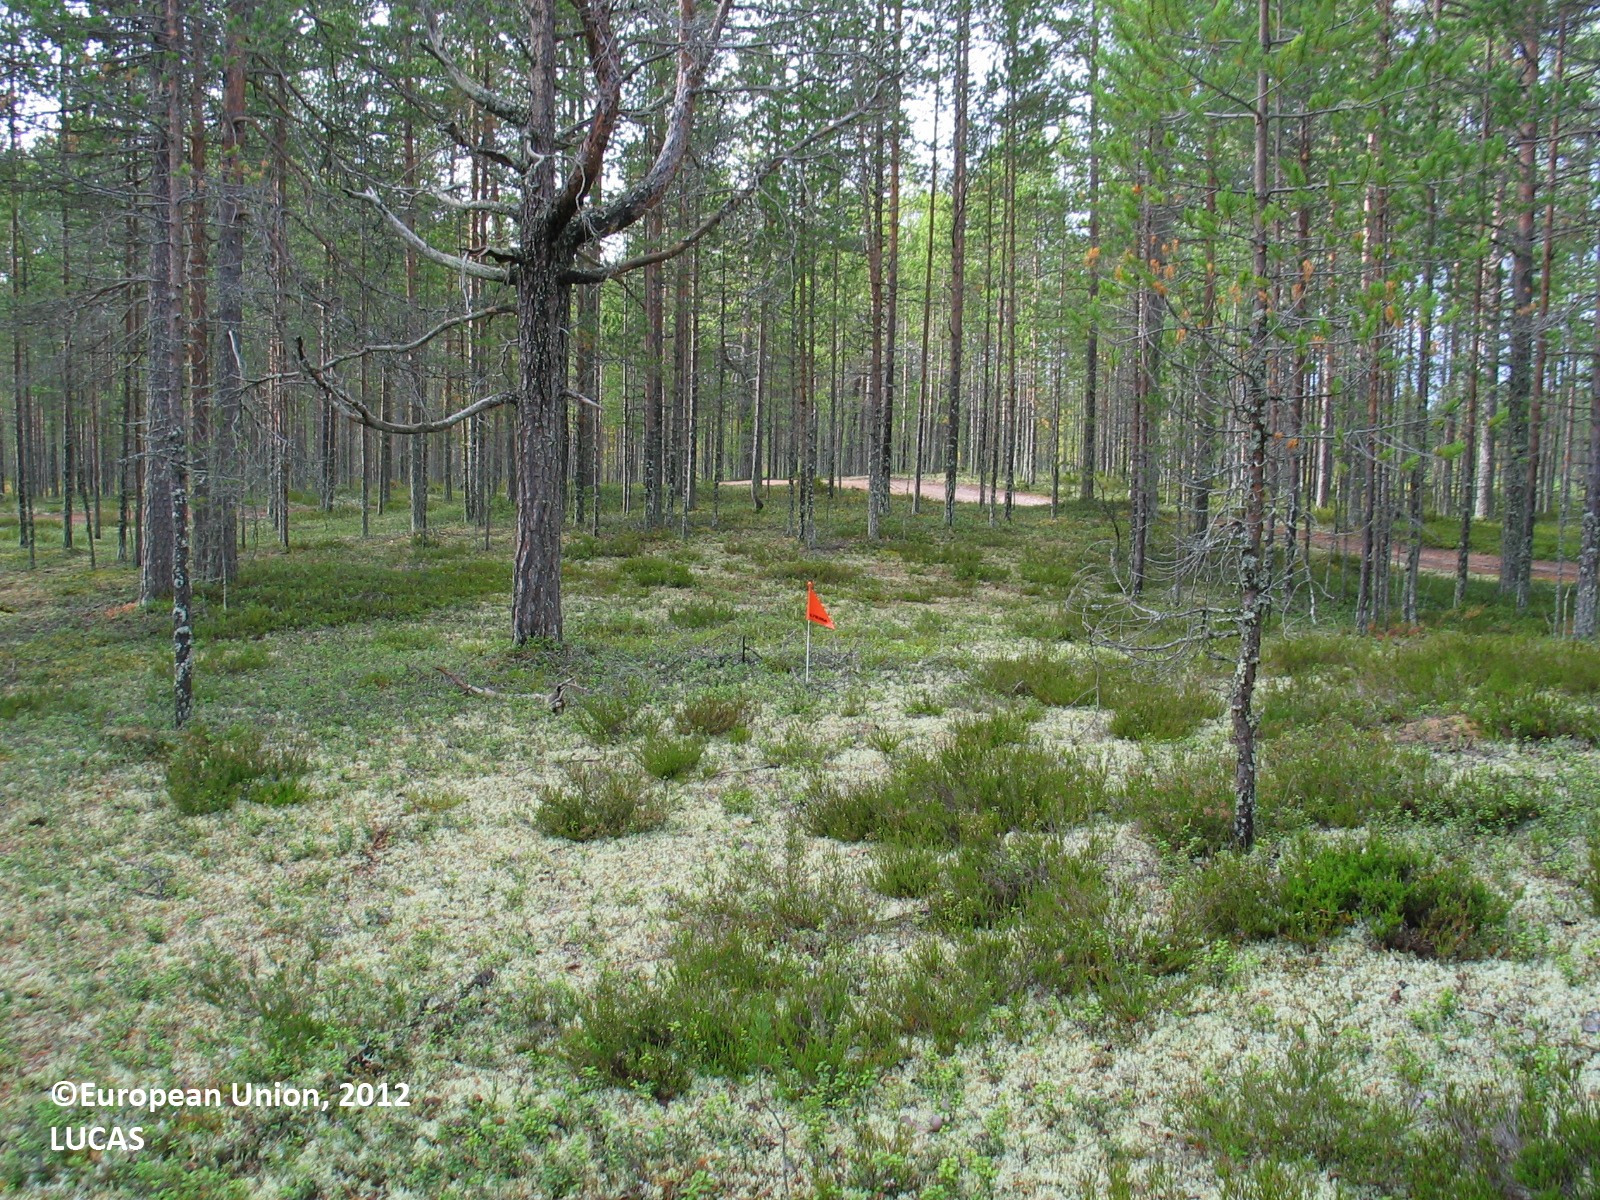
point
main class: Woodland
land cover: Pine dominated coniferous woodland
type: boreal forest
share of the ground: 25 - 50 %
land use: Forestry
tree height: > 5 m
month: September
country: FI
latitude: 65.4175
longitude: 25.5697
